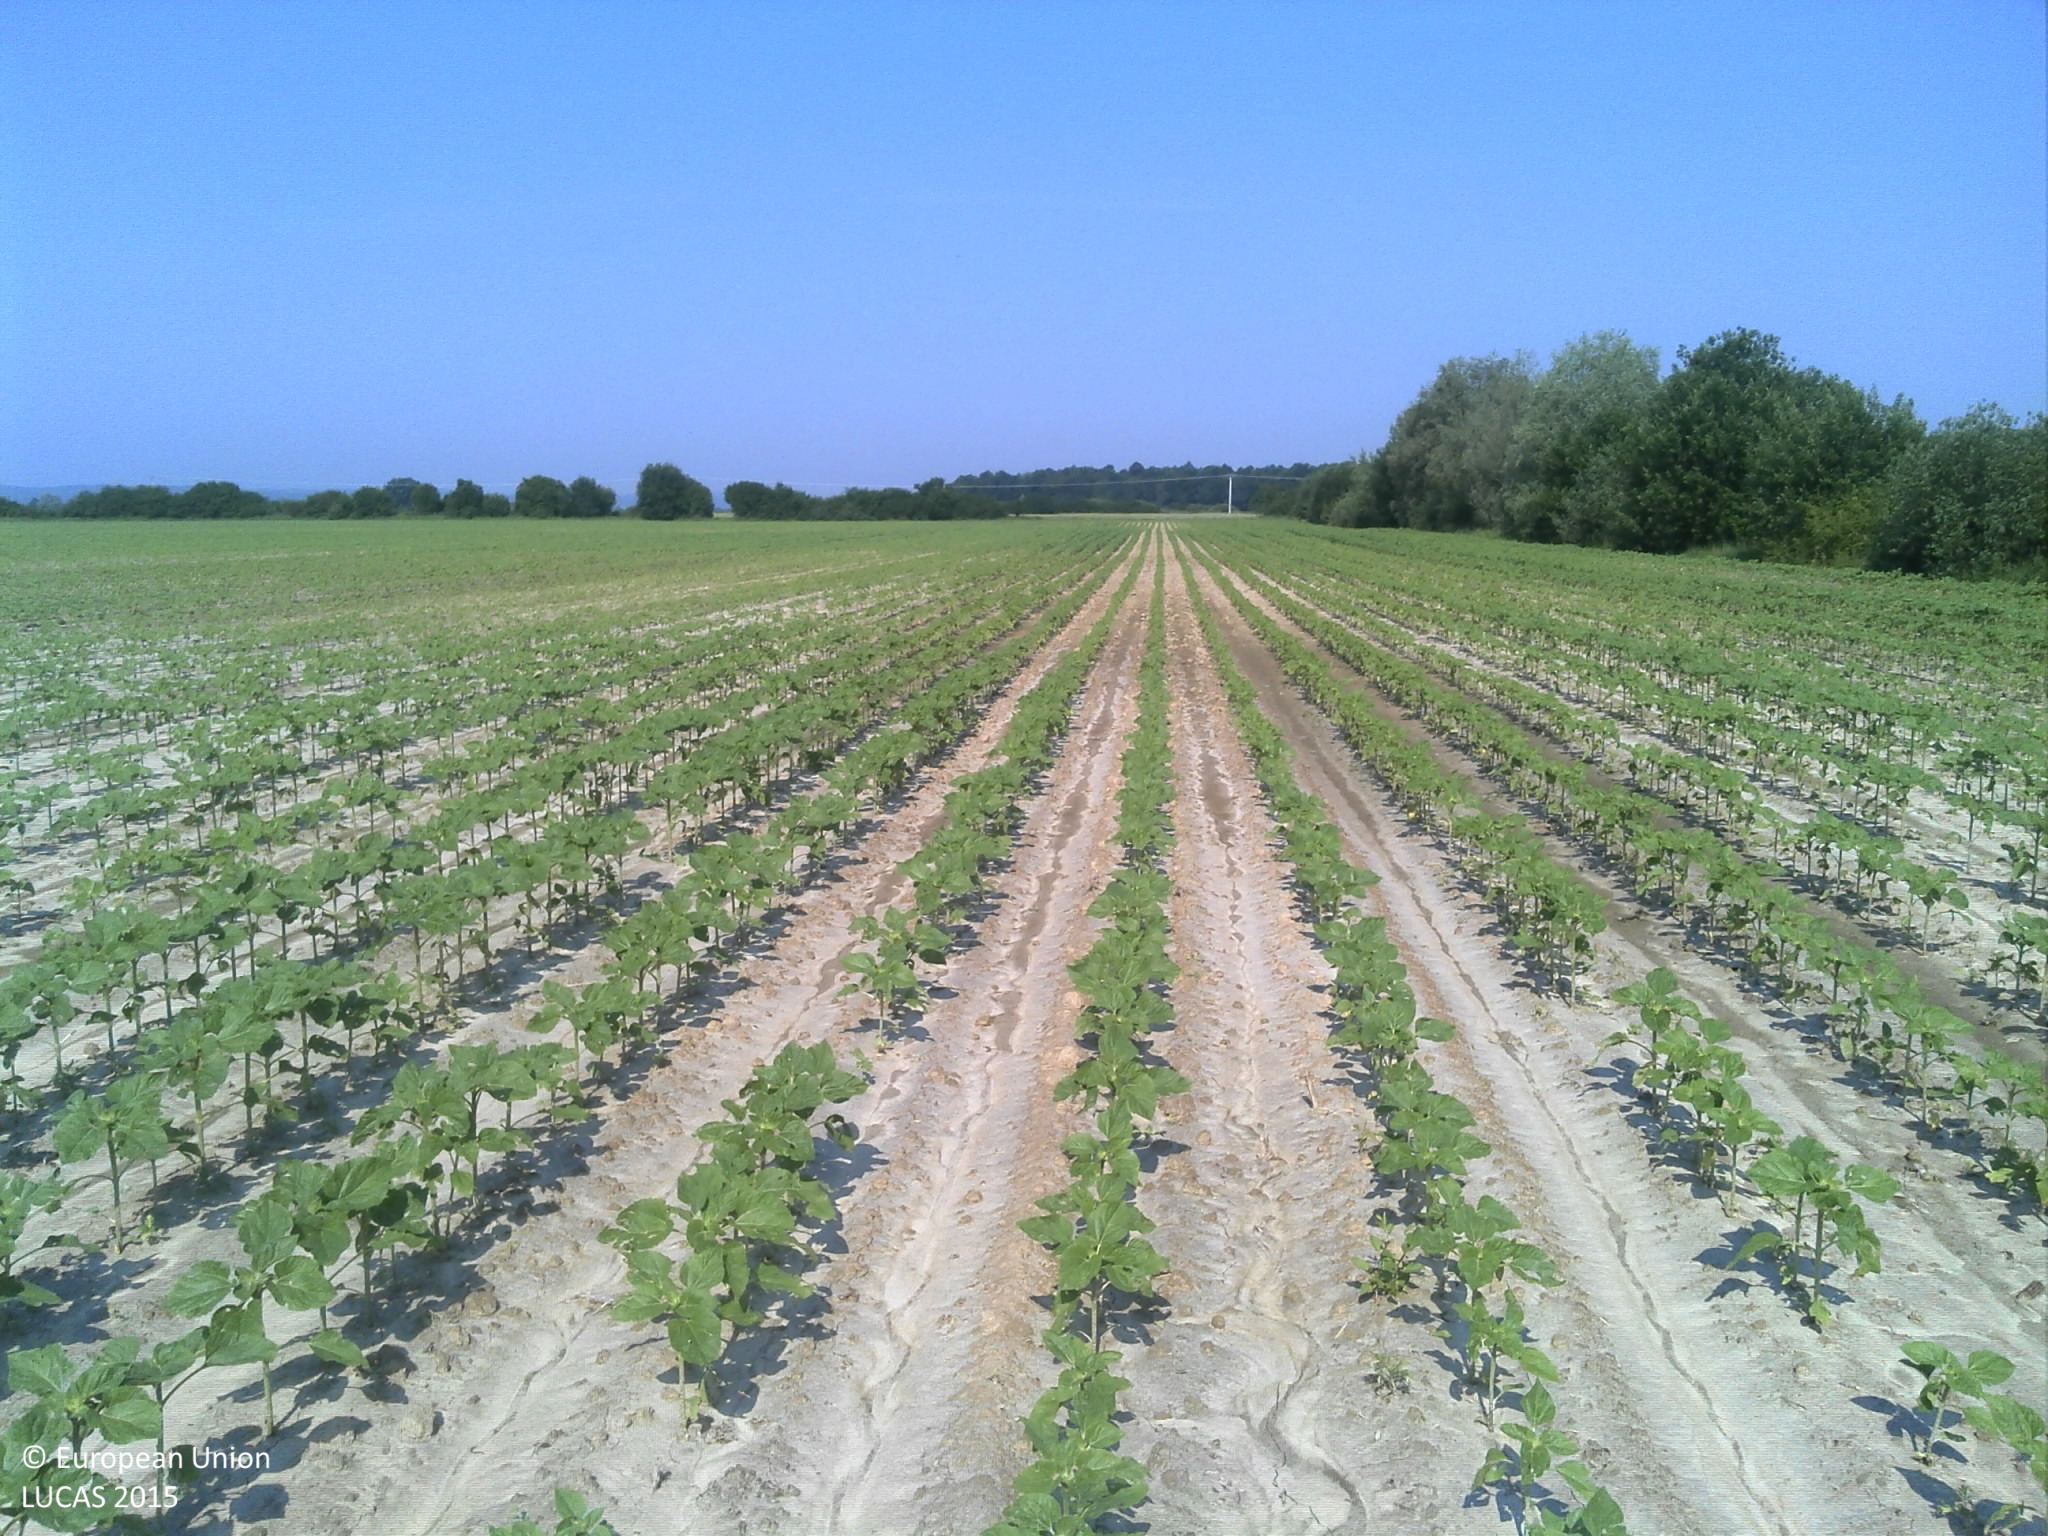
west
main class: Cropland
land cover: Soya
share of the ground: 10 - 25 %
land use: Agriculture (excluding fallow land and kitchen gardens)
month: June
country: HR
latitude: 45.6825
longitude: 17.8485
